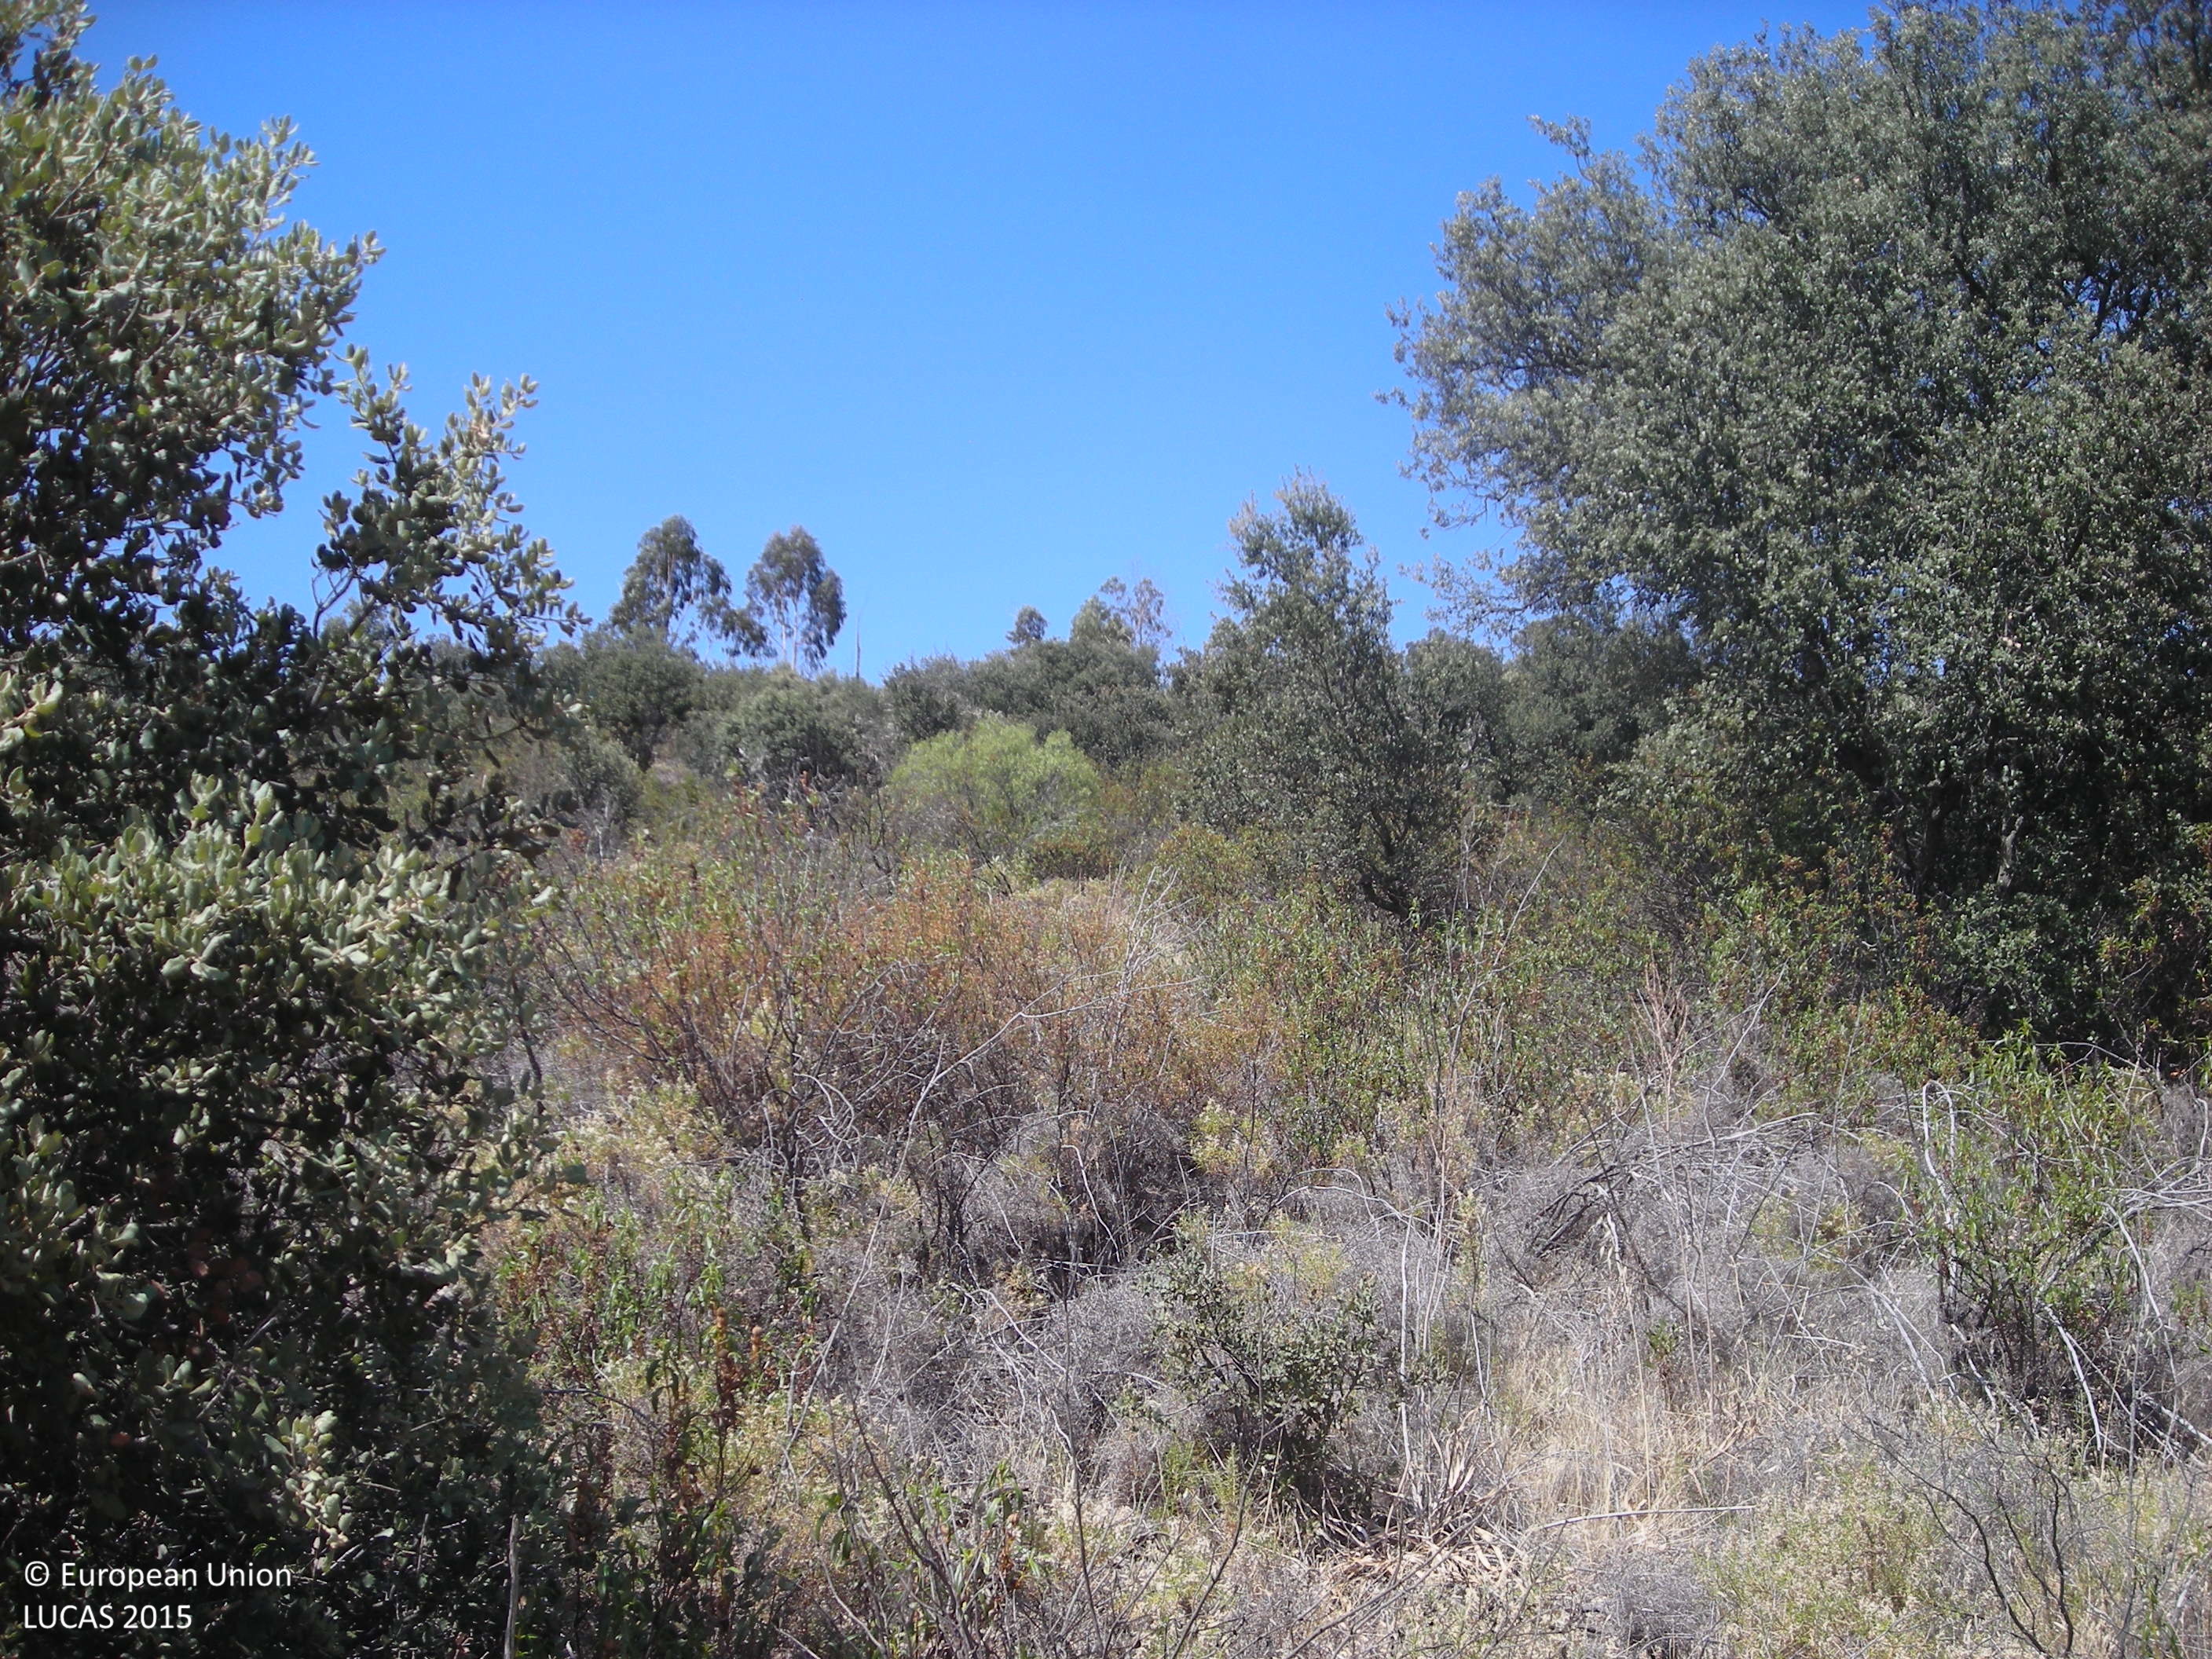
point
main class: Shrubland
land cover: Shrubland with sparse tree cover
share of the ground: > 75 %
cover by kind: shrubs 95 %, broadleaved forest trees 5 %
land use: Semi-natural and natural areas not in use
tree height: > 5 m
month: June
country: ES
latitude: 38.6437
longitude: -5.8180
